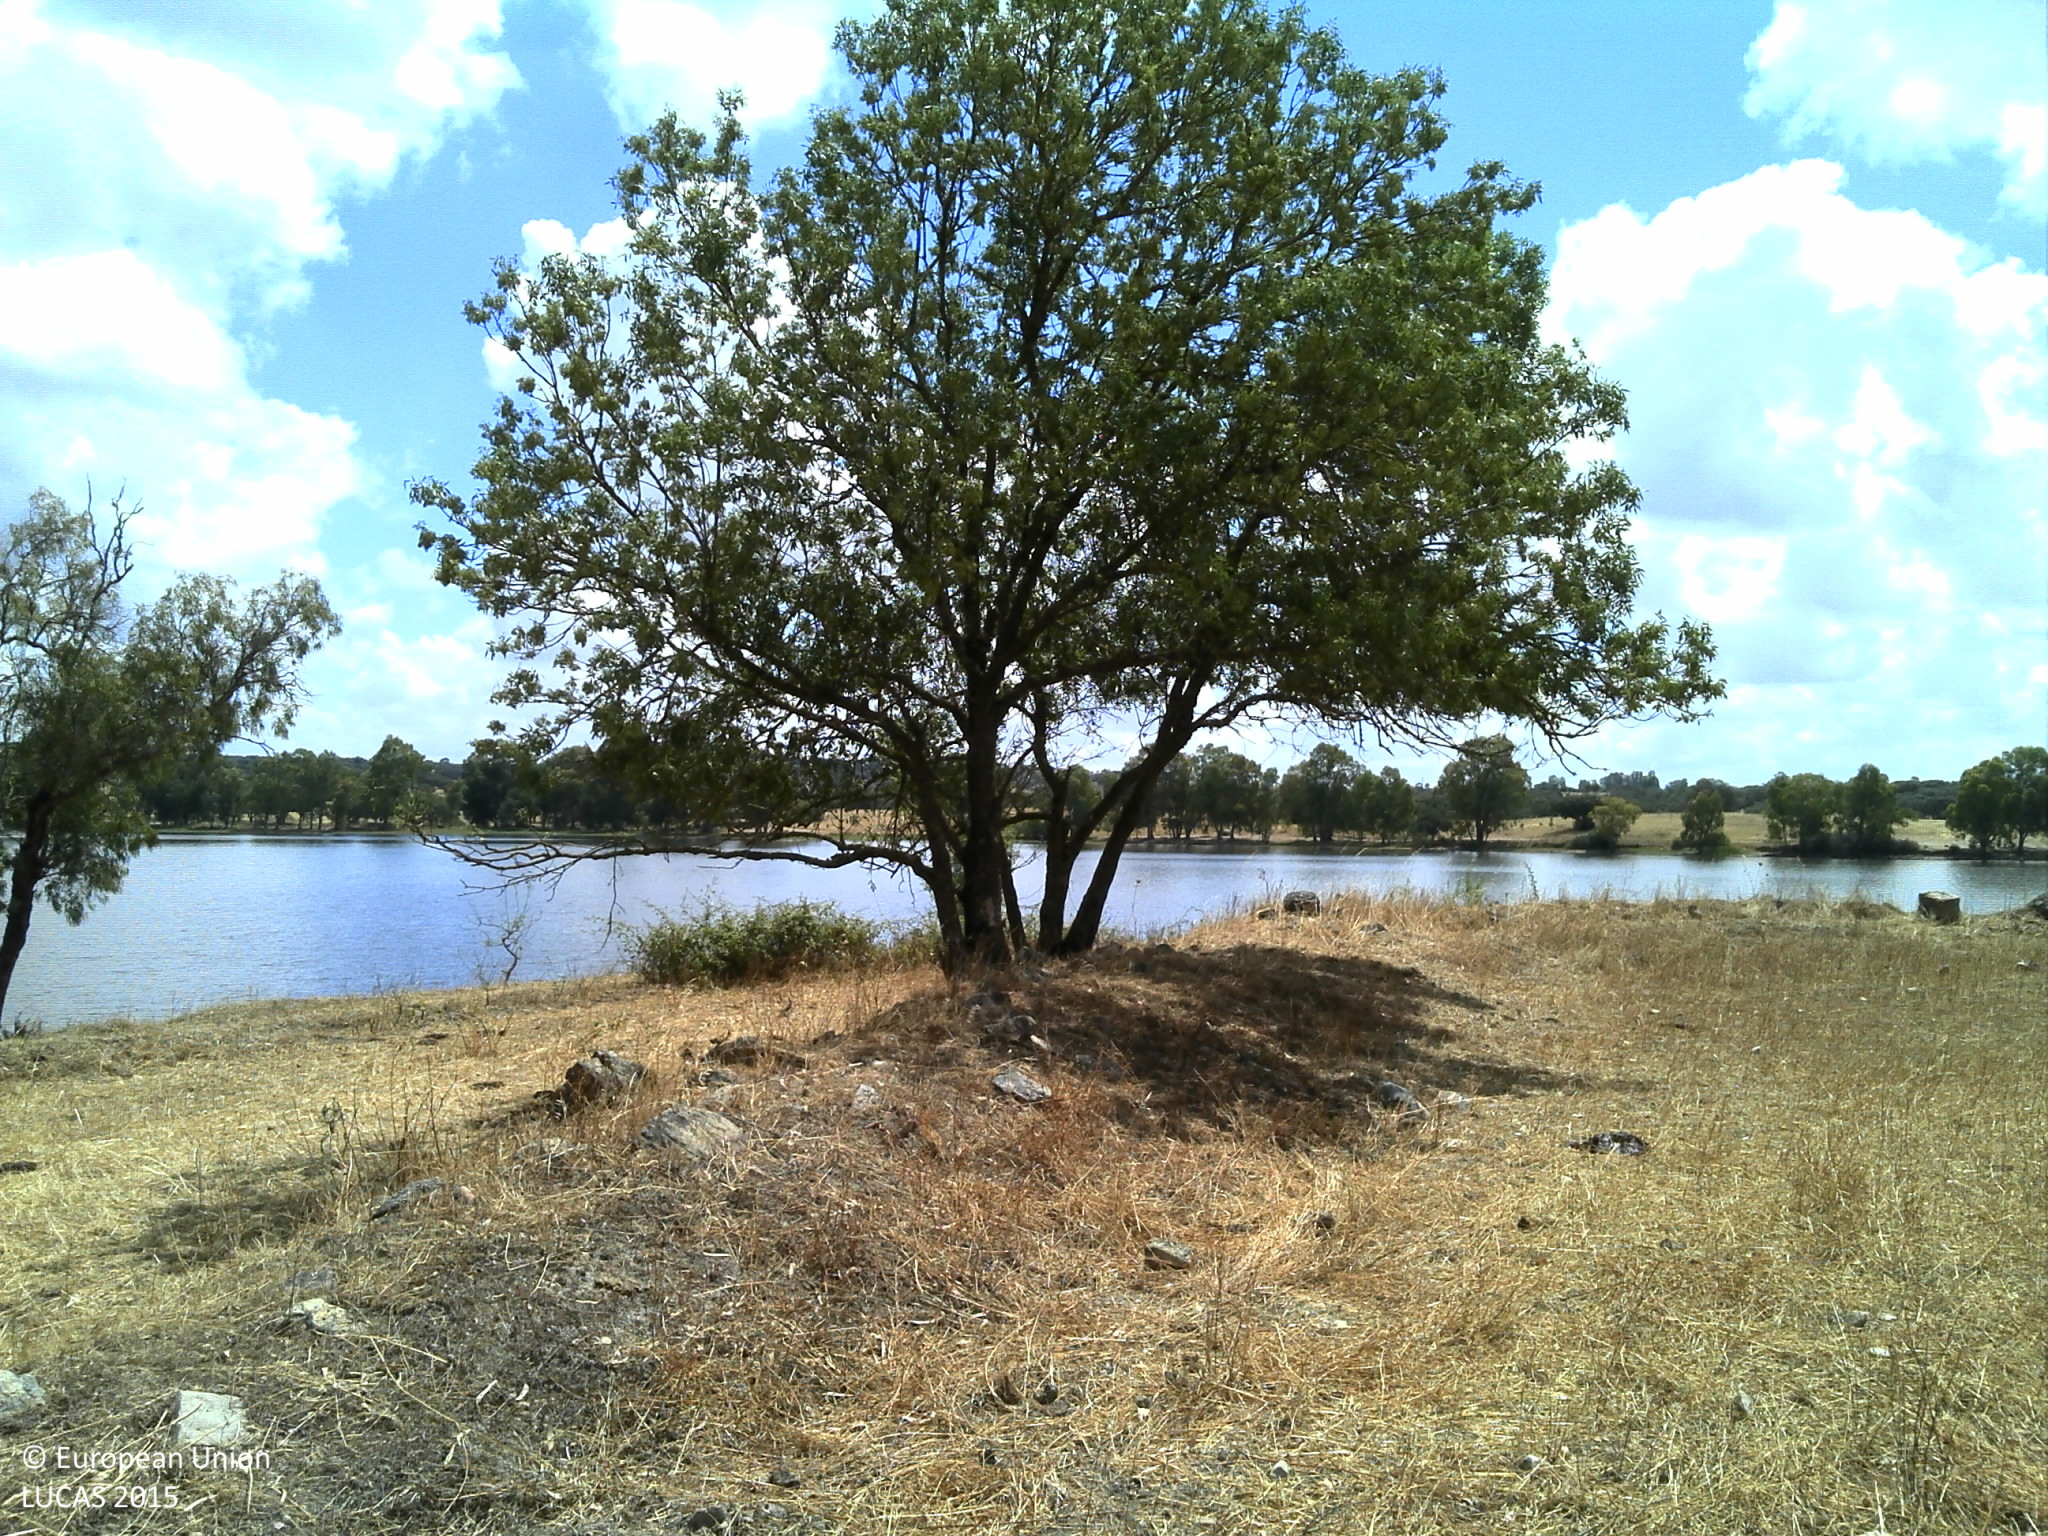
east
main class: Grassland
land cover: Grassland without tree/shrub cover
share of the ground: 25 - 50 %
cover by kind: unconsolidated bare surface 65 %, herbaceous plants 35 %
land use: Agriculture (excluding fallow land and kitchen gardens)
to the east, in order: Grassland without tree/shrub cover; Single bushes/trees; Grassland without tree/shrub cover; Inland fresh water bodies
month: June
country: PT
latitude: 38.5066
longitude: -8.0337
